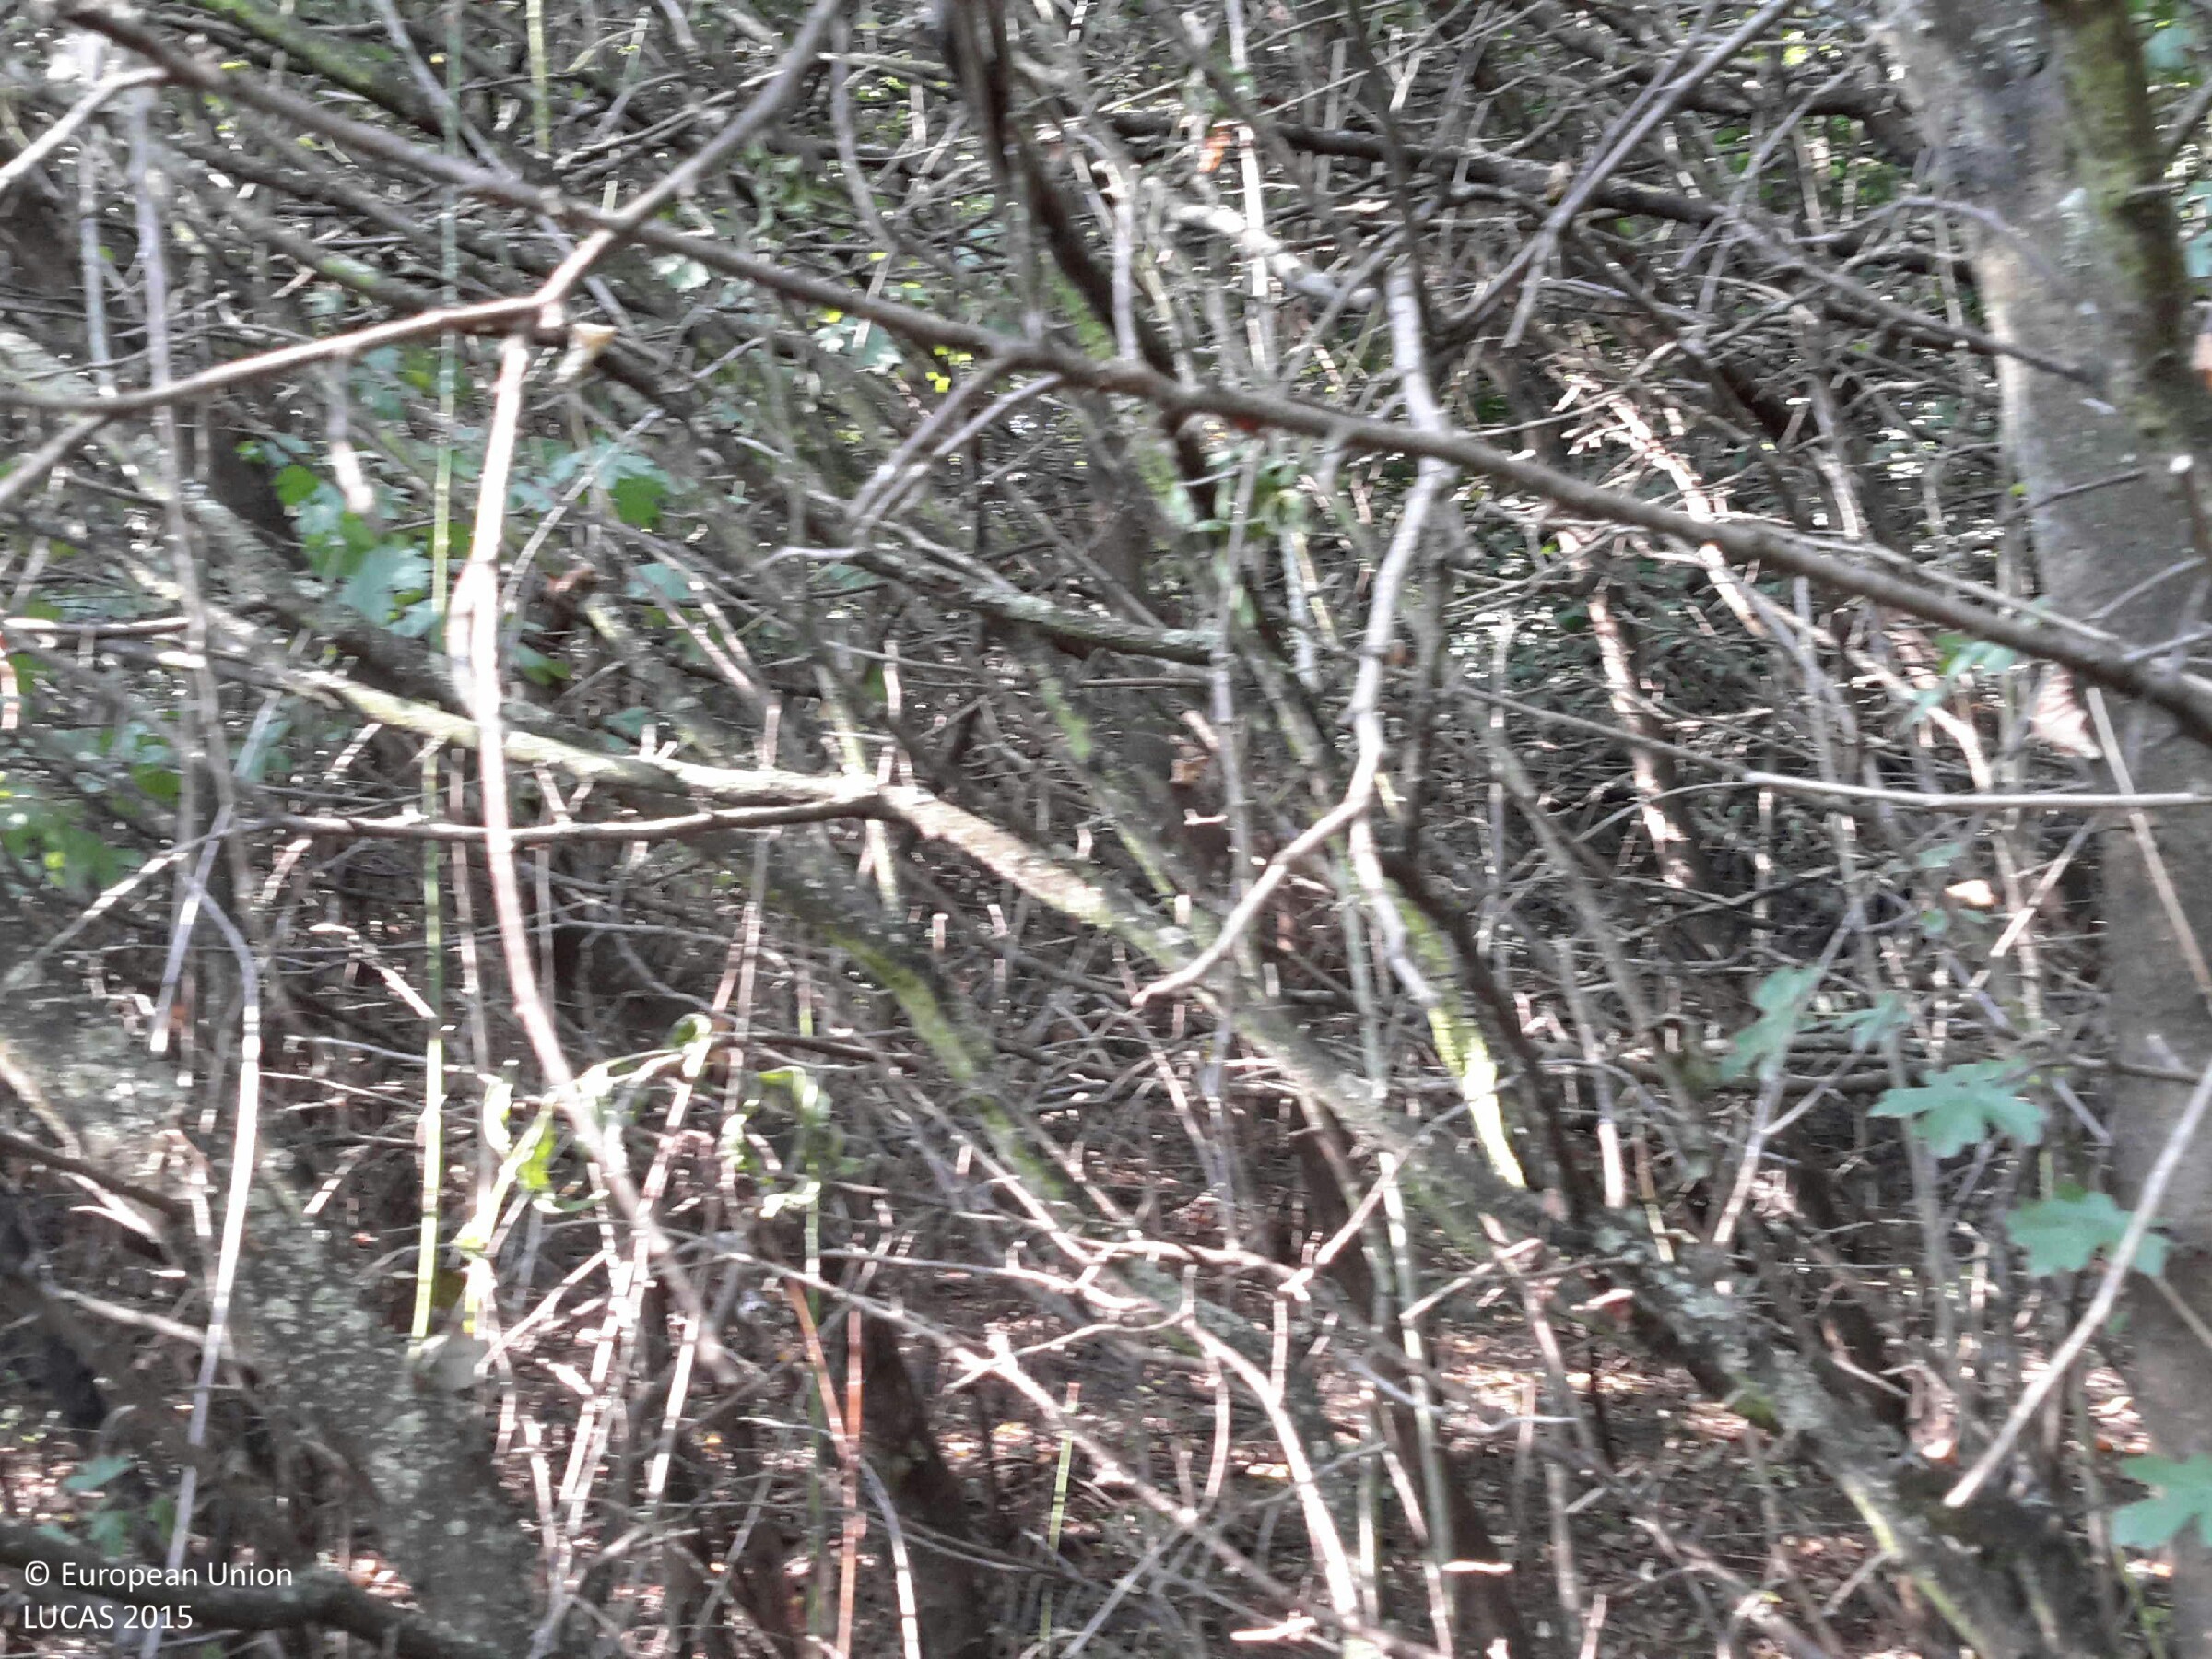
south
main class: Woodland
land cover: Broadleaved woodland
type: mesophytic deciduous forest
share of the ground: > 75 %
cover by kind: broadleaved forest trees 90 %, shrubs 5 %, herbaceous plants 5 %
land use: Forestry
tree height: > 5 m
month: August
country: HU
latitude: 47.9196
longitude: 17.1400
